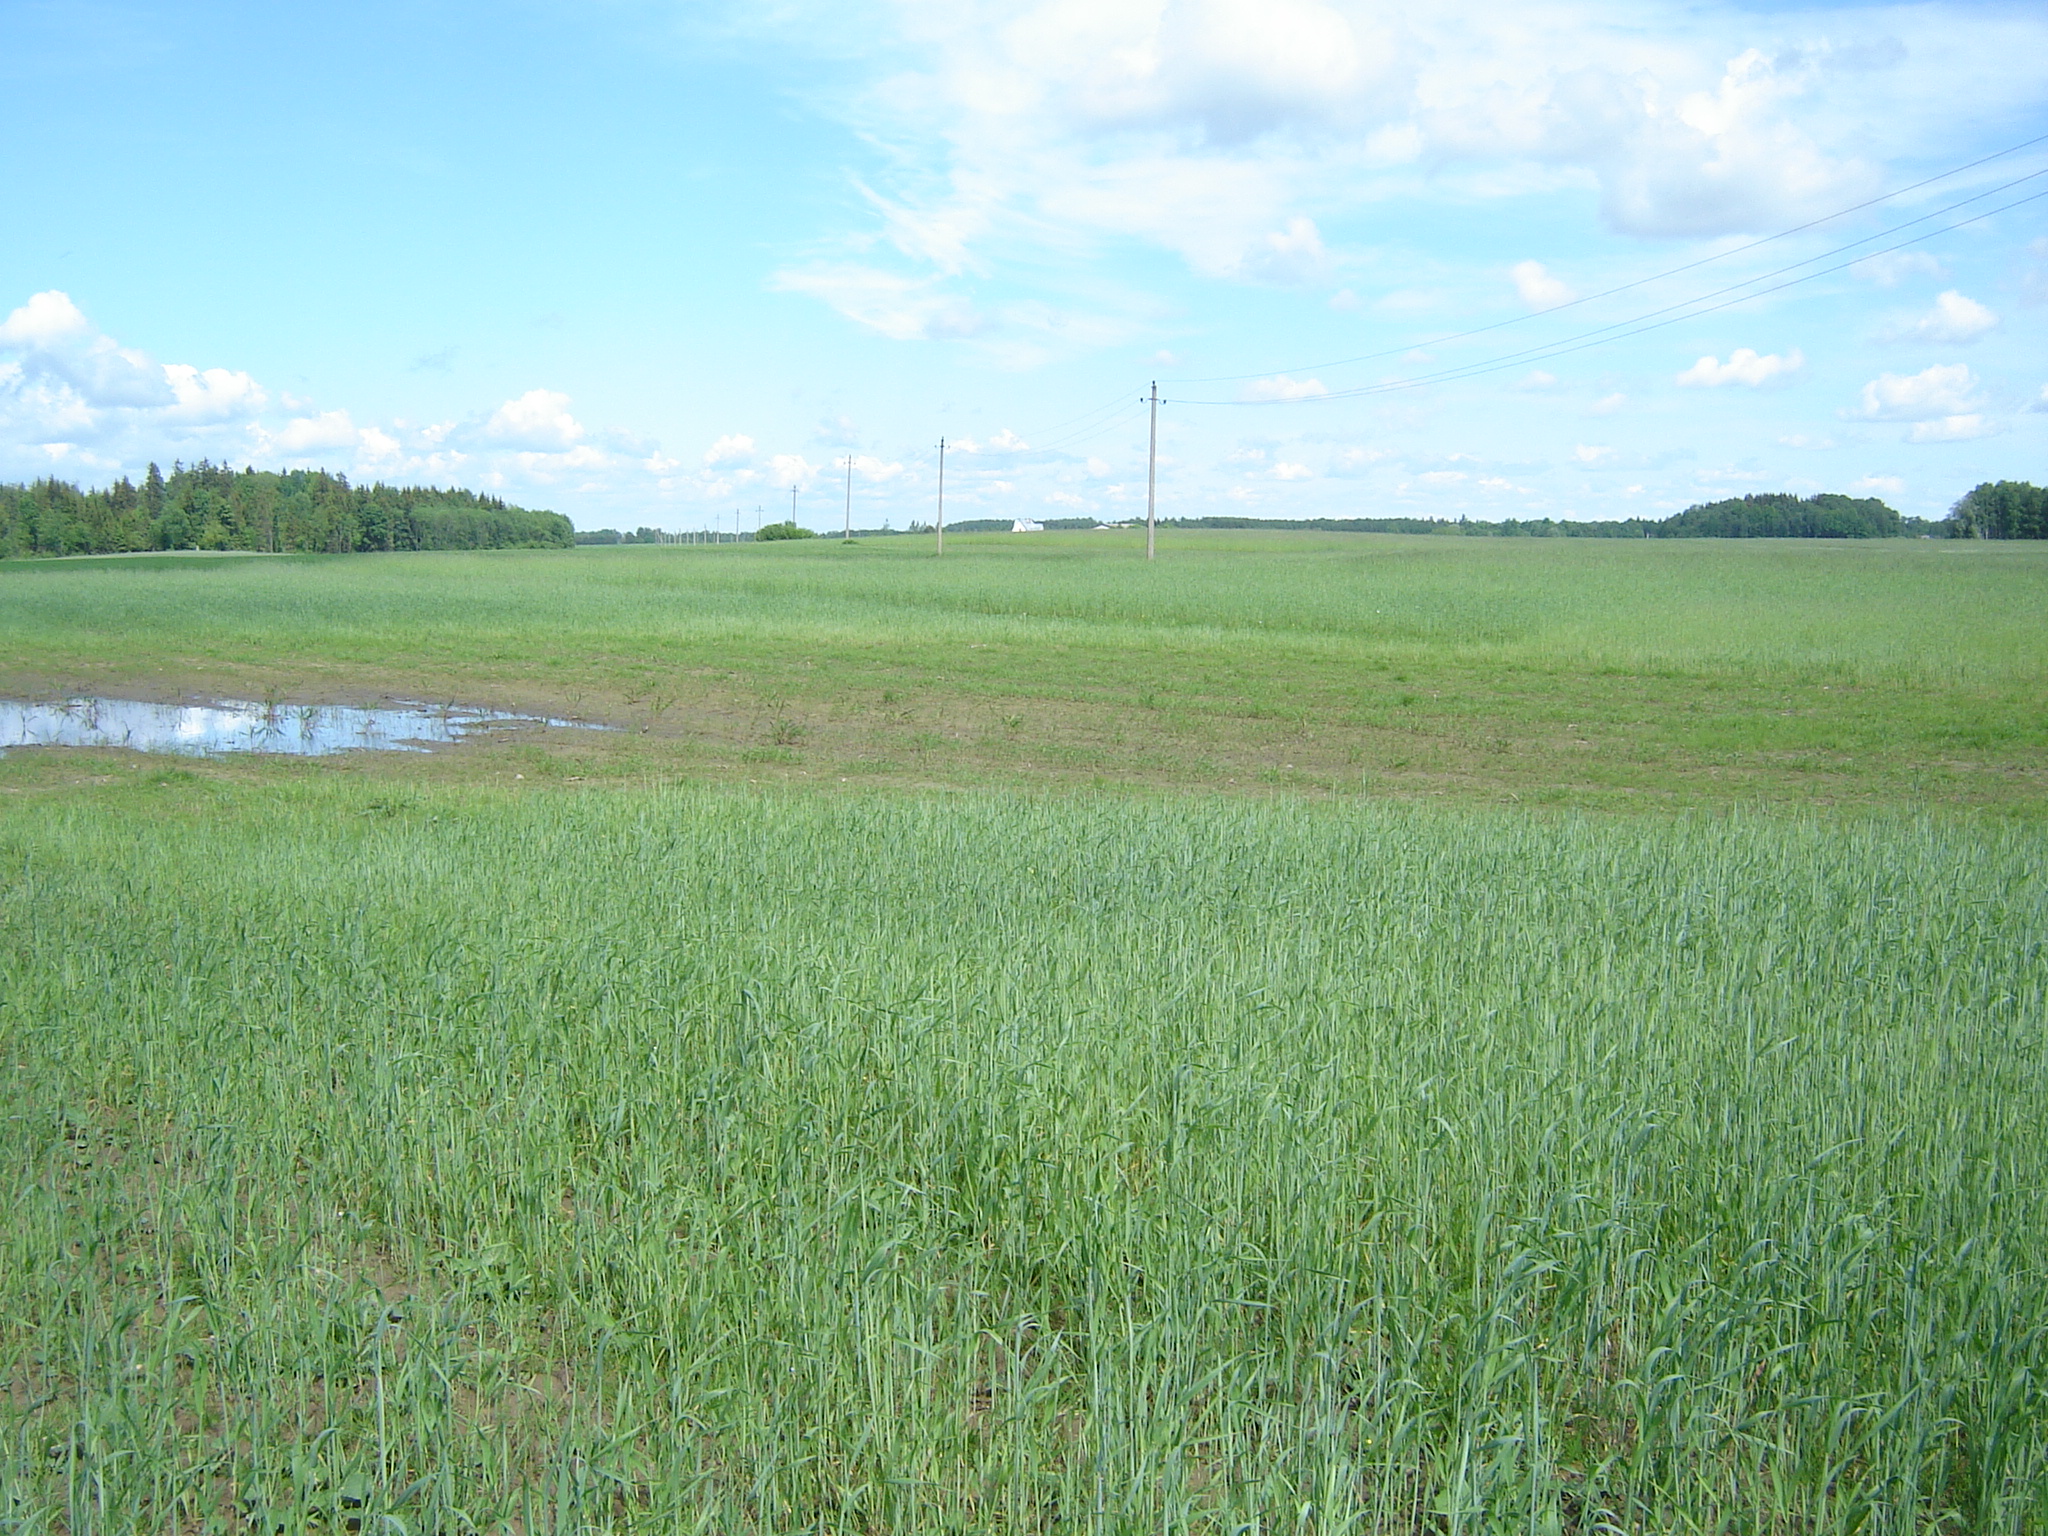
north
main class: Cropland
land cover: Rye
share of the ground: > 75 %
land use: Agriculture (excluding fallow land and kitchen gardens)
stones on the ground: < 10 %
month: May
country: LT
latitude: 55.7933
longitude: 25.1550
